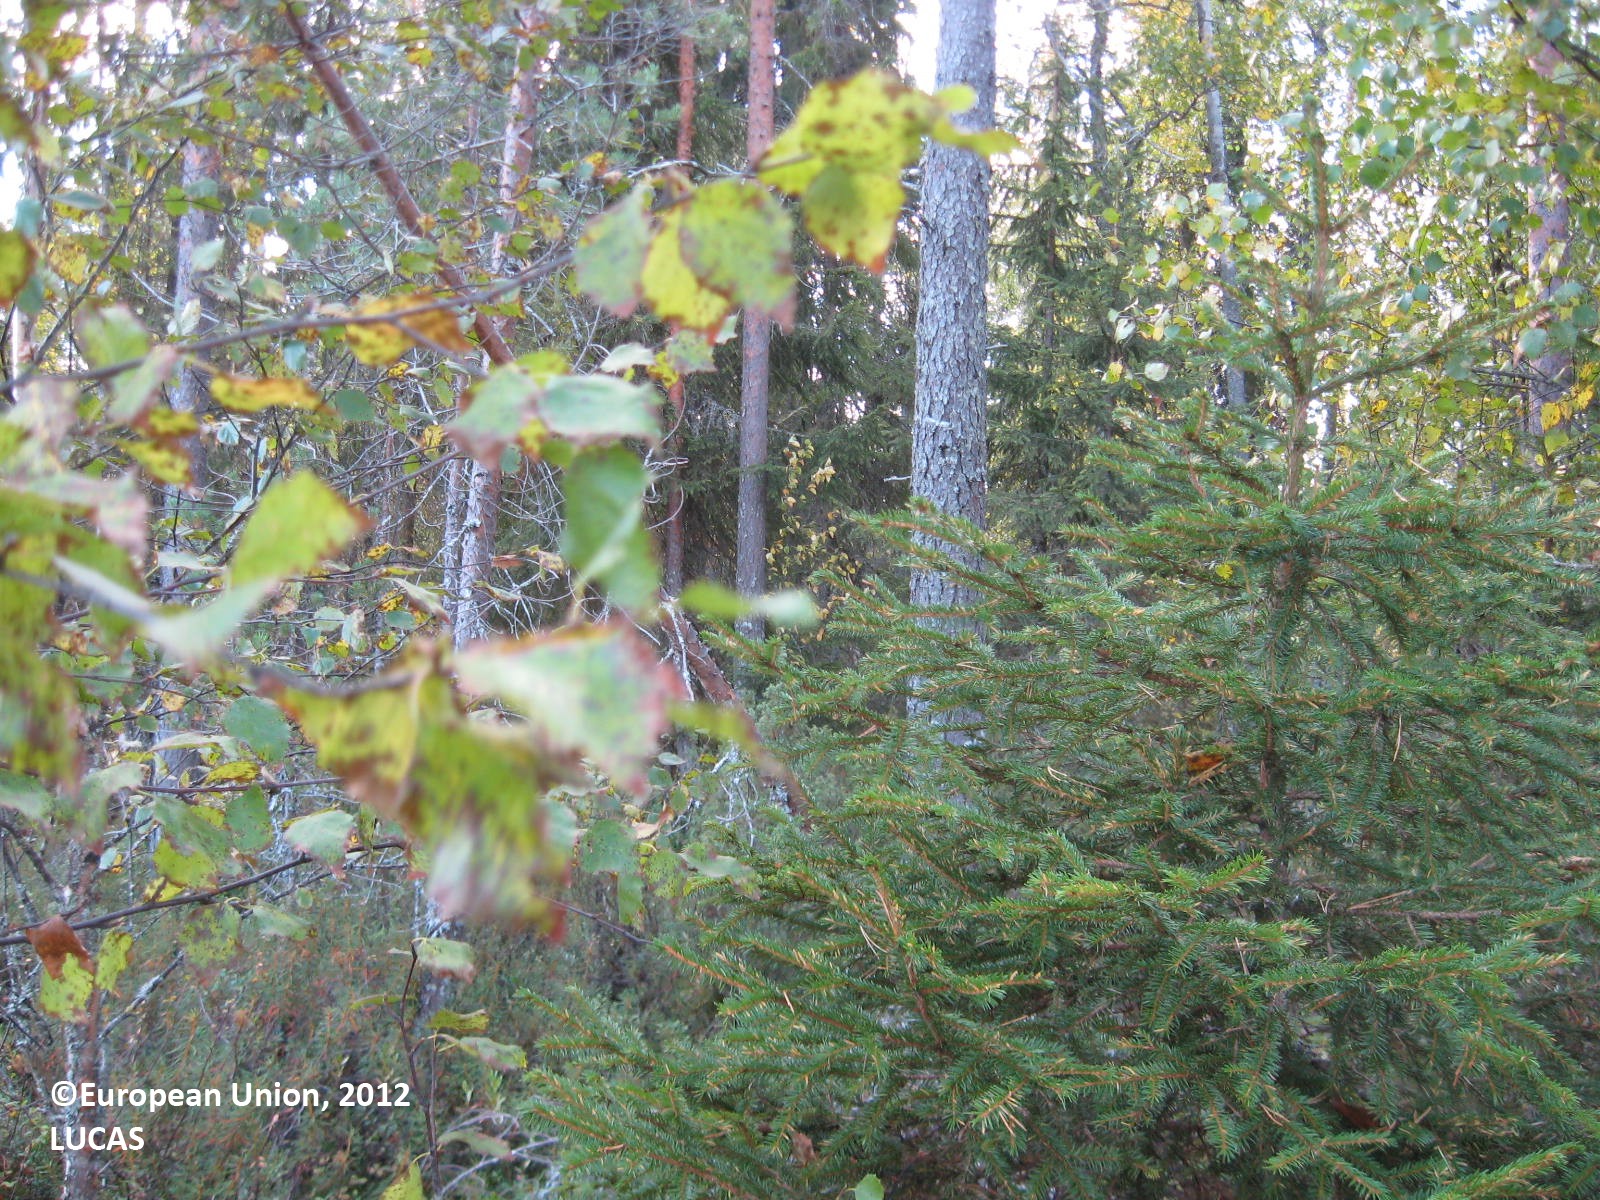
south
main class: Woodland
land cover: Pine dominated coniferous woodland
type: boreal forest
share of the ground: > 75 %
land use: Forestry
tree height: > 5 m
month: August
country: FI
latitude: 63.7505
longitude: 29.9188
